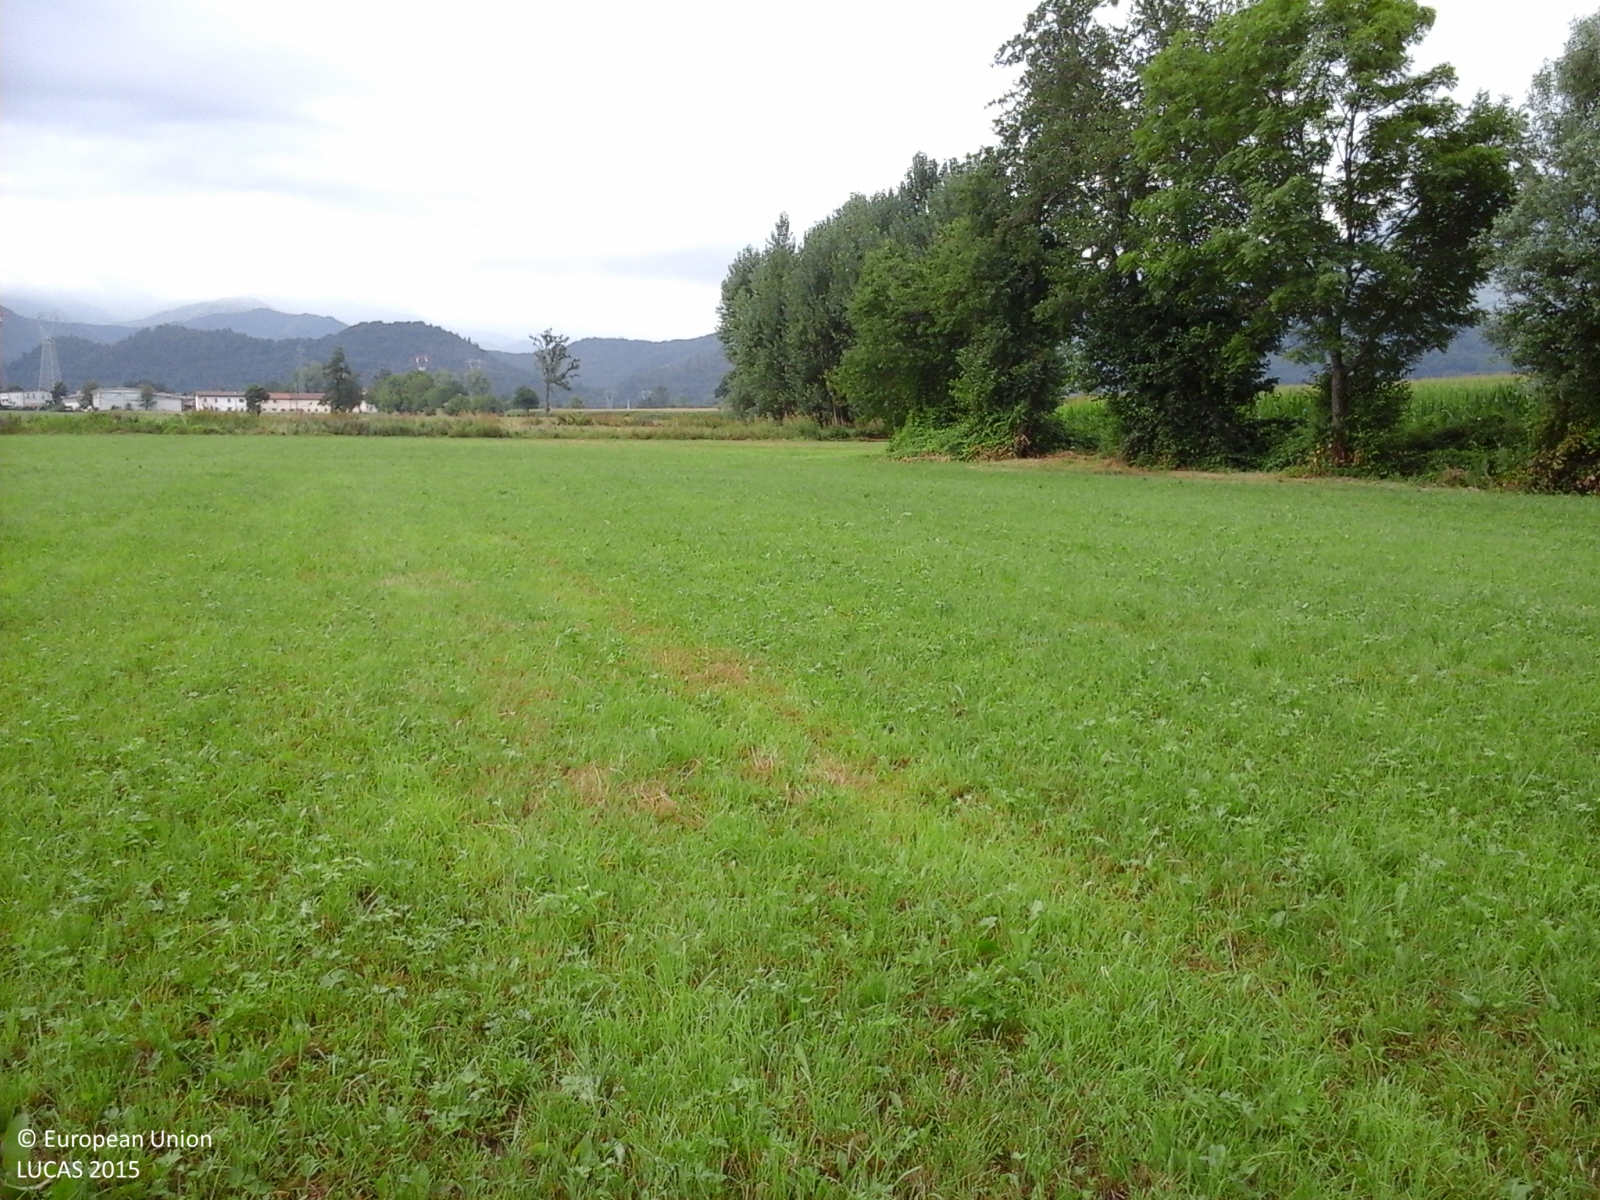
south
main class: Grassland
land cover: Grassland without tree/shrub cover
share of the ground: > 75 %
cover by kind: herbaceous plants 100 %
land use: Agriculture (excluding fallow land and kitchen gardens)
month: July
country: IT
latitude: 44.3422
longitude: 7.6594
